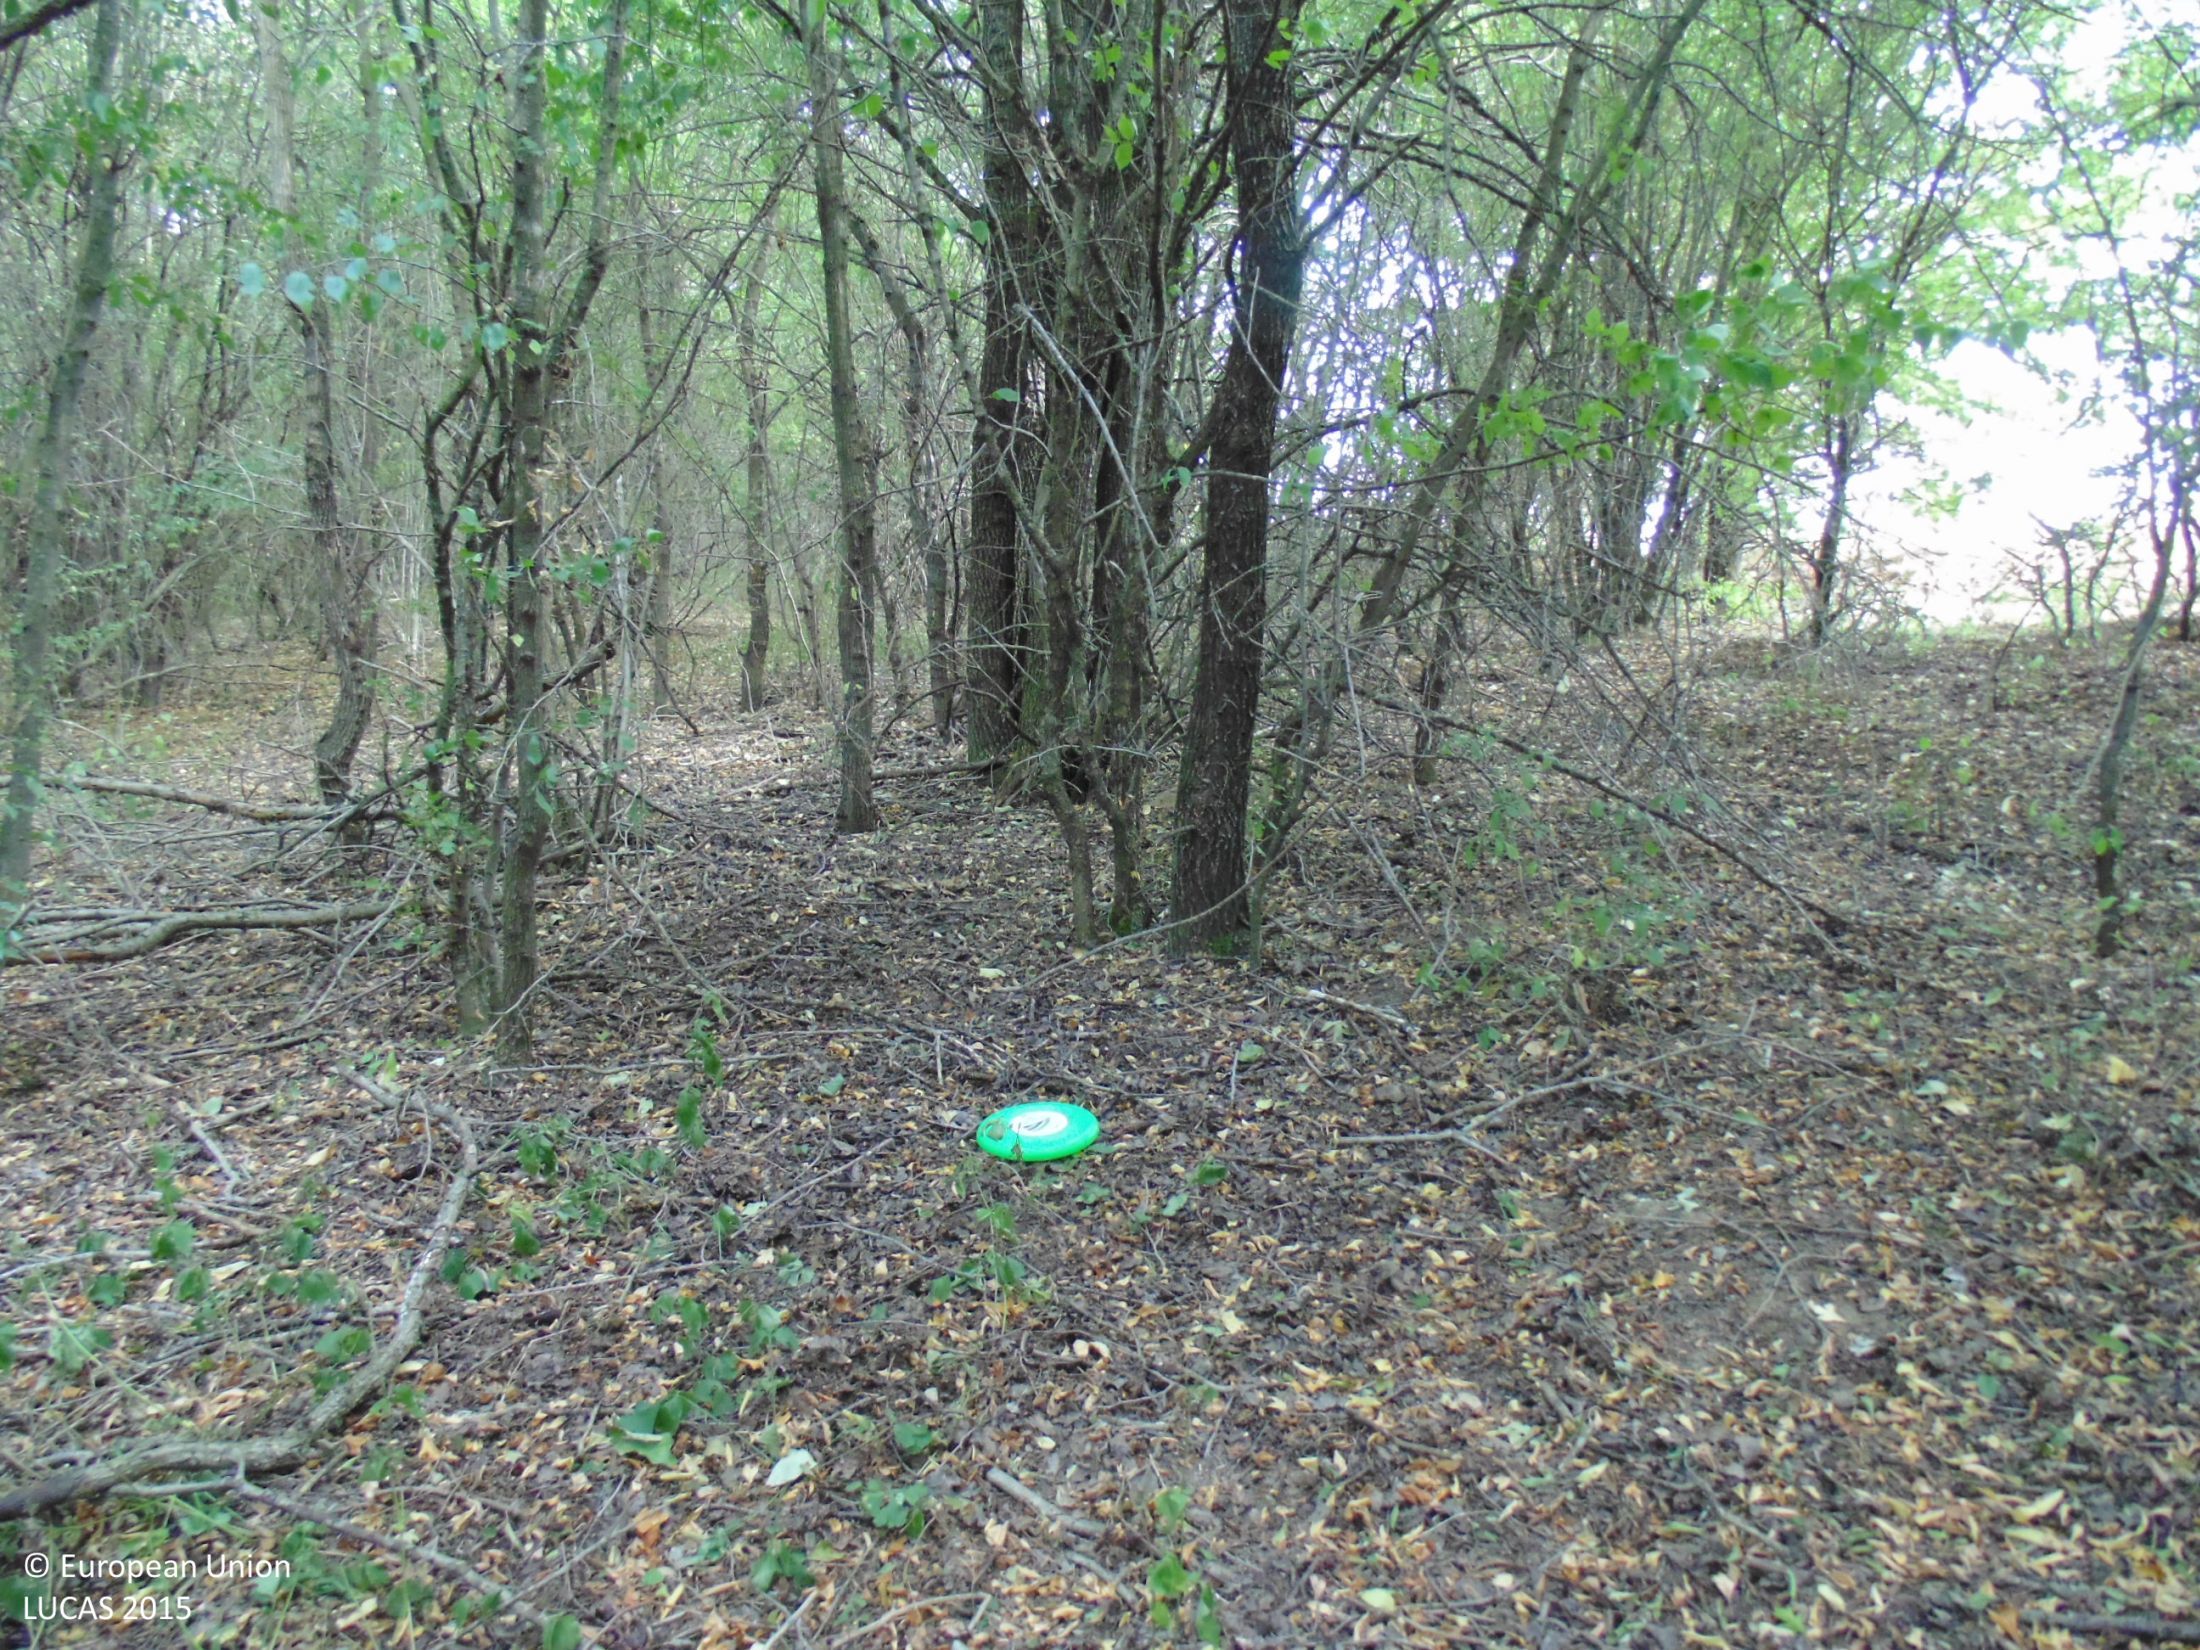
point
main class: Woodland
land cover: Broadleaved woodland
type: mesophytic deciduous forest
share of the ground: > 75 %
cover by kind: broadleaved forest trees 95 %, unconsolidated bare surface 5 %
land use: Forestry
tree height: > 5 m
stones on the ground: < 10 %
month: August
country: BG
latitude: 43.9127
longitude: 27.6359
